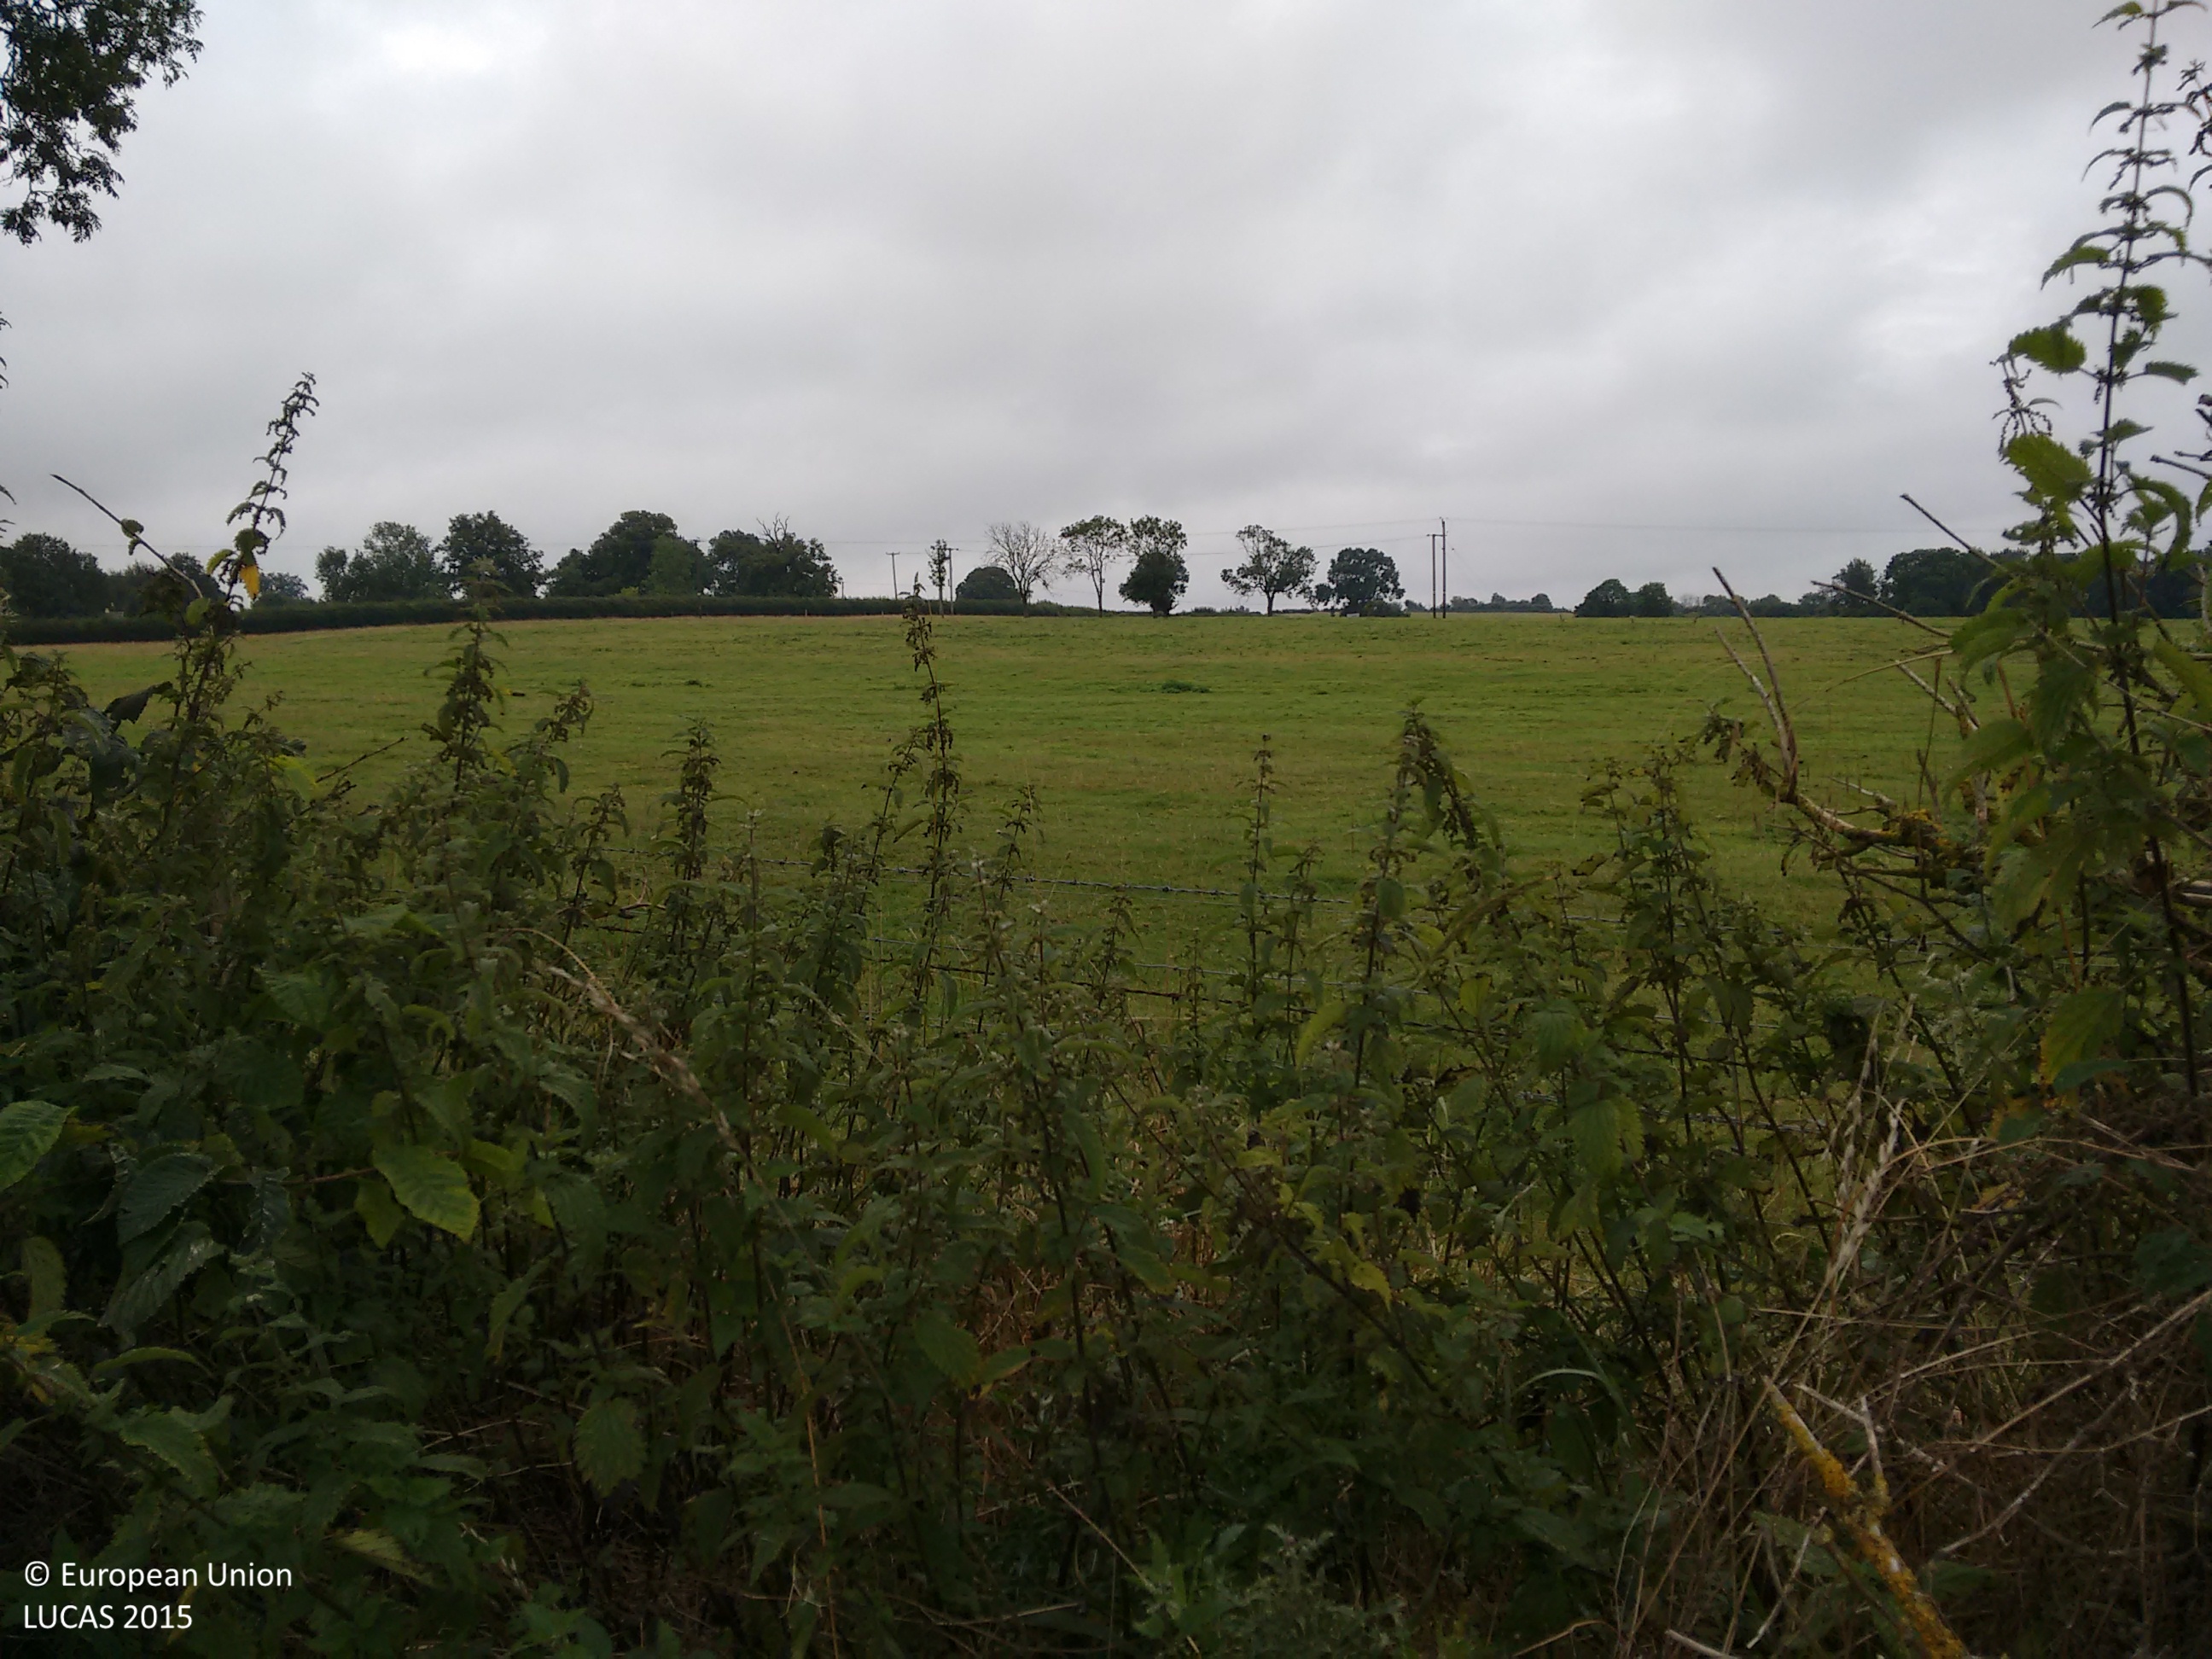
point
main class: Grassland
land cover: Grassland without tree/shrub cover
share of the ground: > 75 %
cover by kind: herbaceous plants 100 %
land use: Agriculture (excluding fallow land and kitchen gardens)
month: September
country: GB
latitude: 52.5061
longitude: -1.3190
